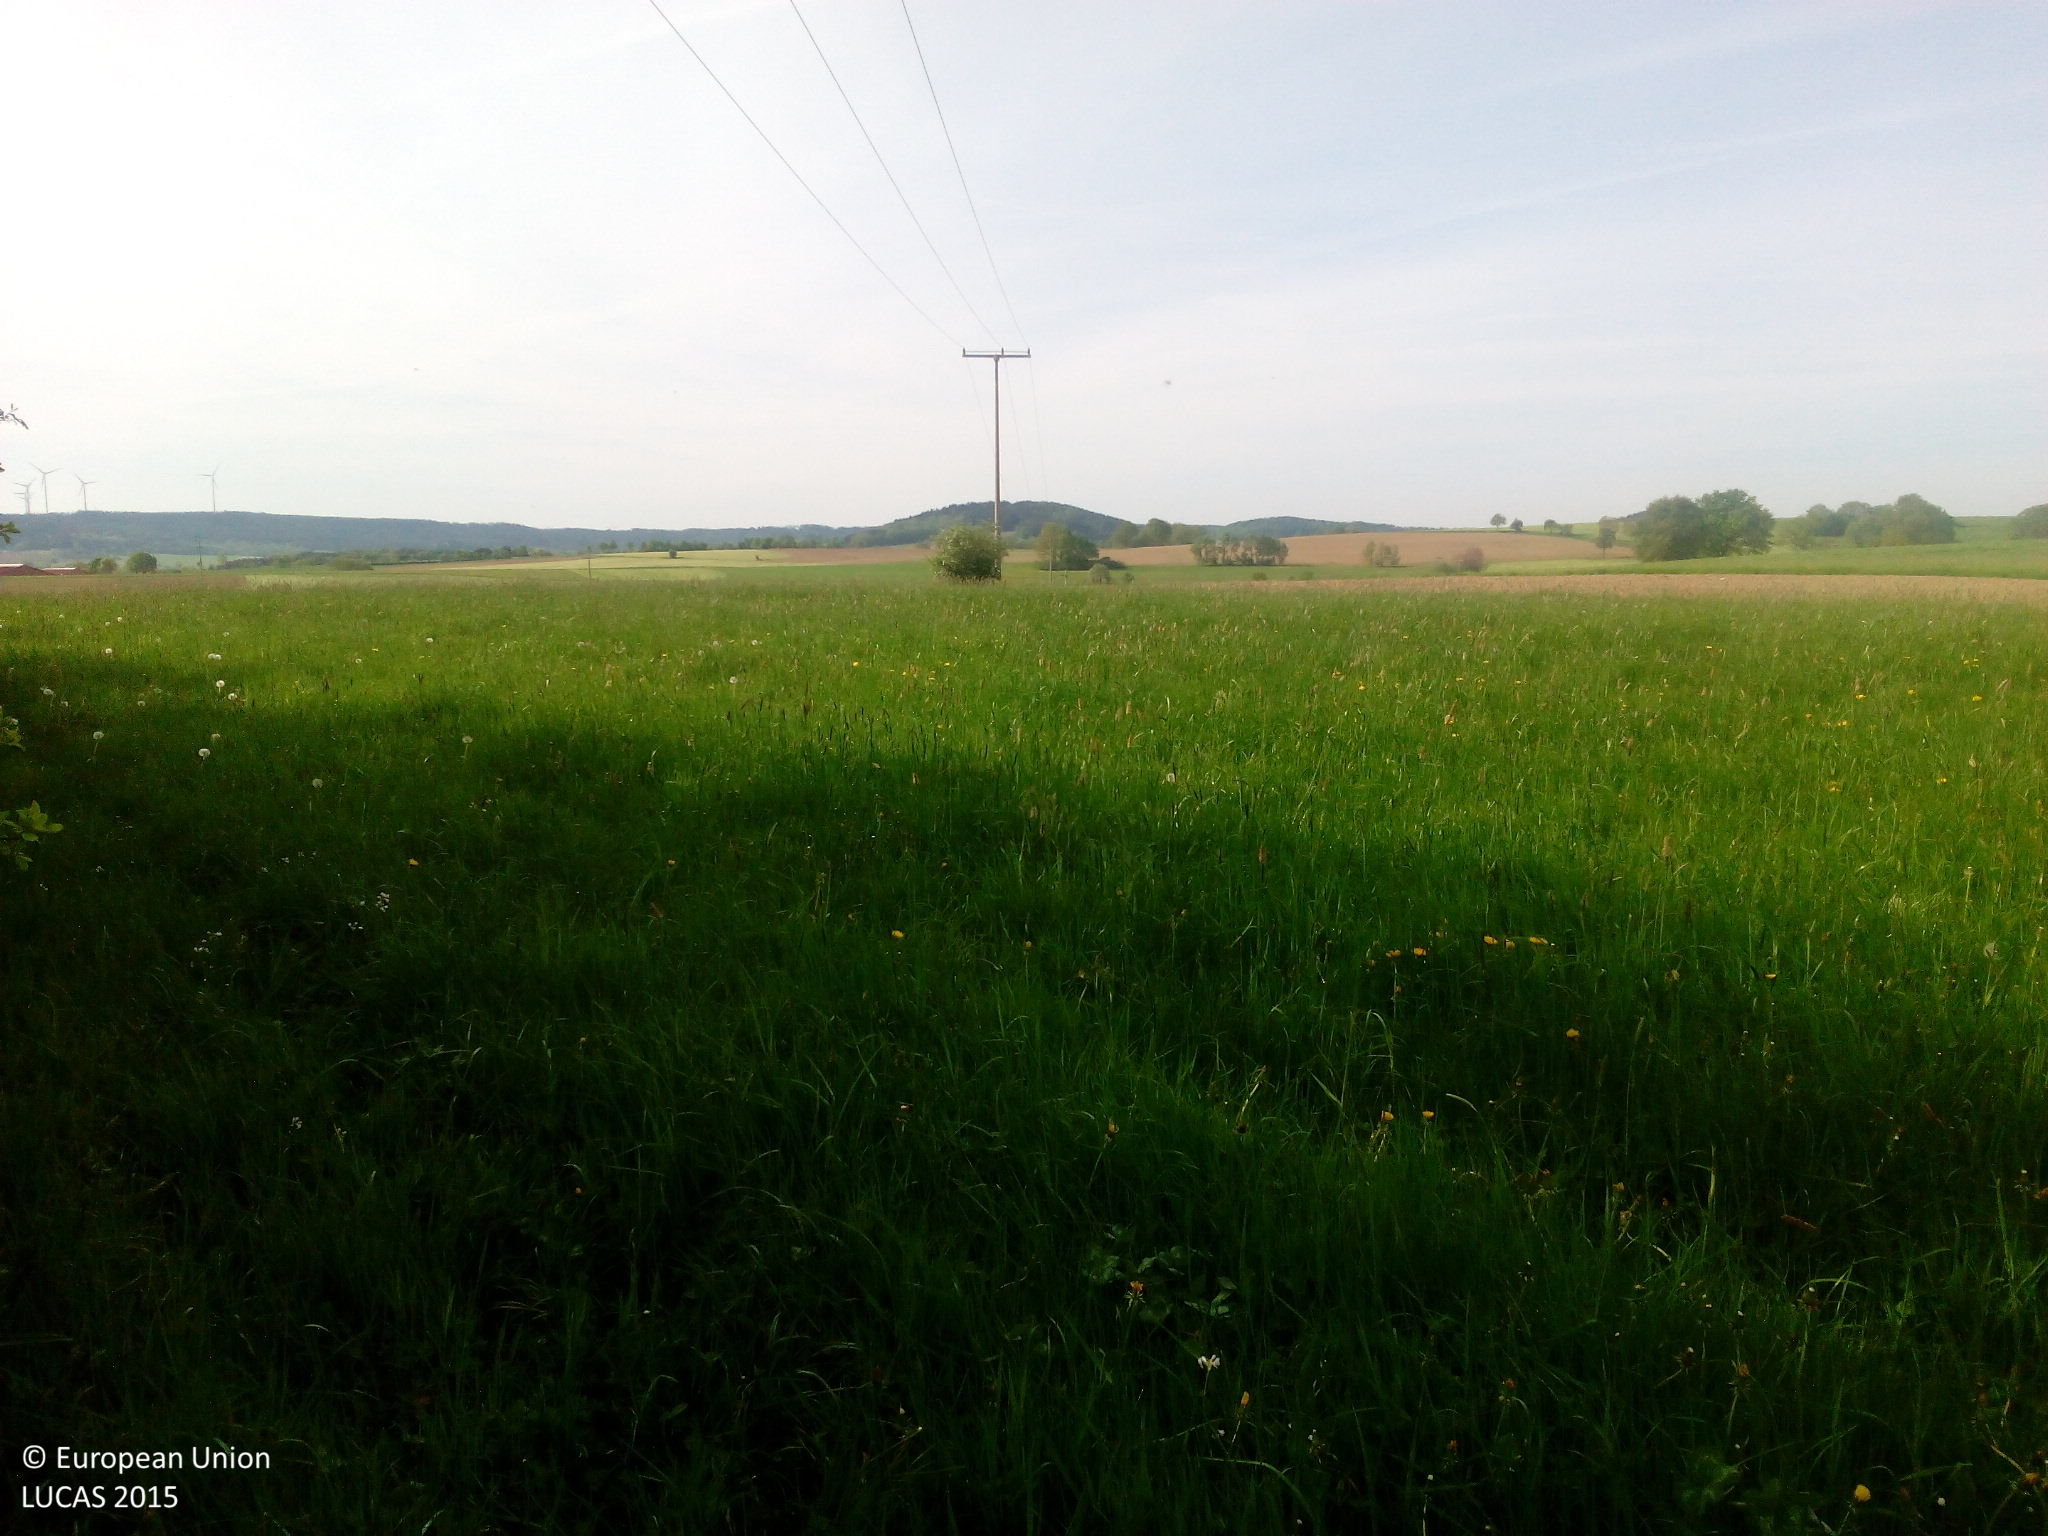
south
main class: Shrubland
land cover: Shrubland with sparse tree cover
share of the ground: > 75 %
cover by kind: shrubs 95 %, broadleaved forest trees 5 %
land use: Semi-natural and natural areas not in use
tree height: < 5 m
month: May
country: DE
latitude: 49.9227
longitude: 11.4900
